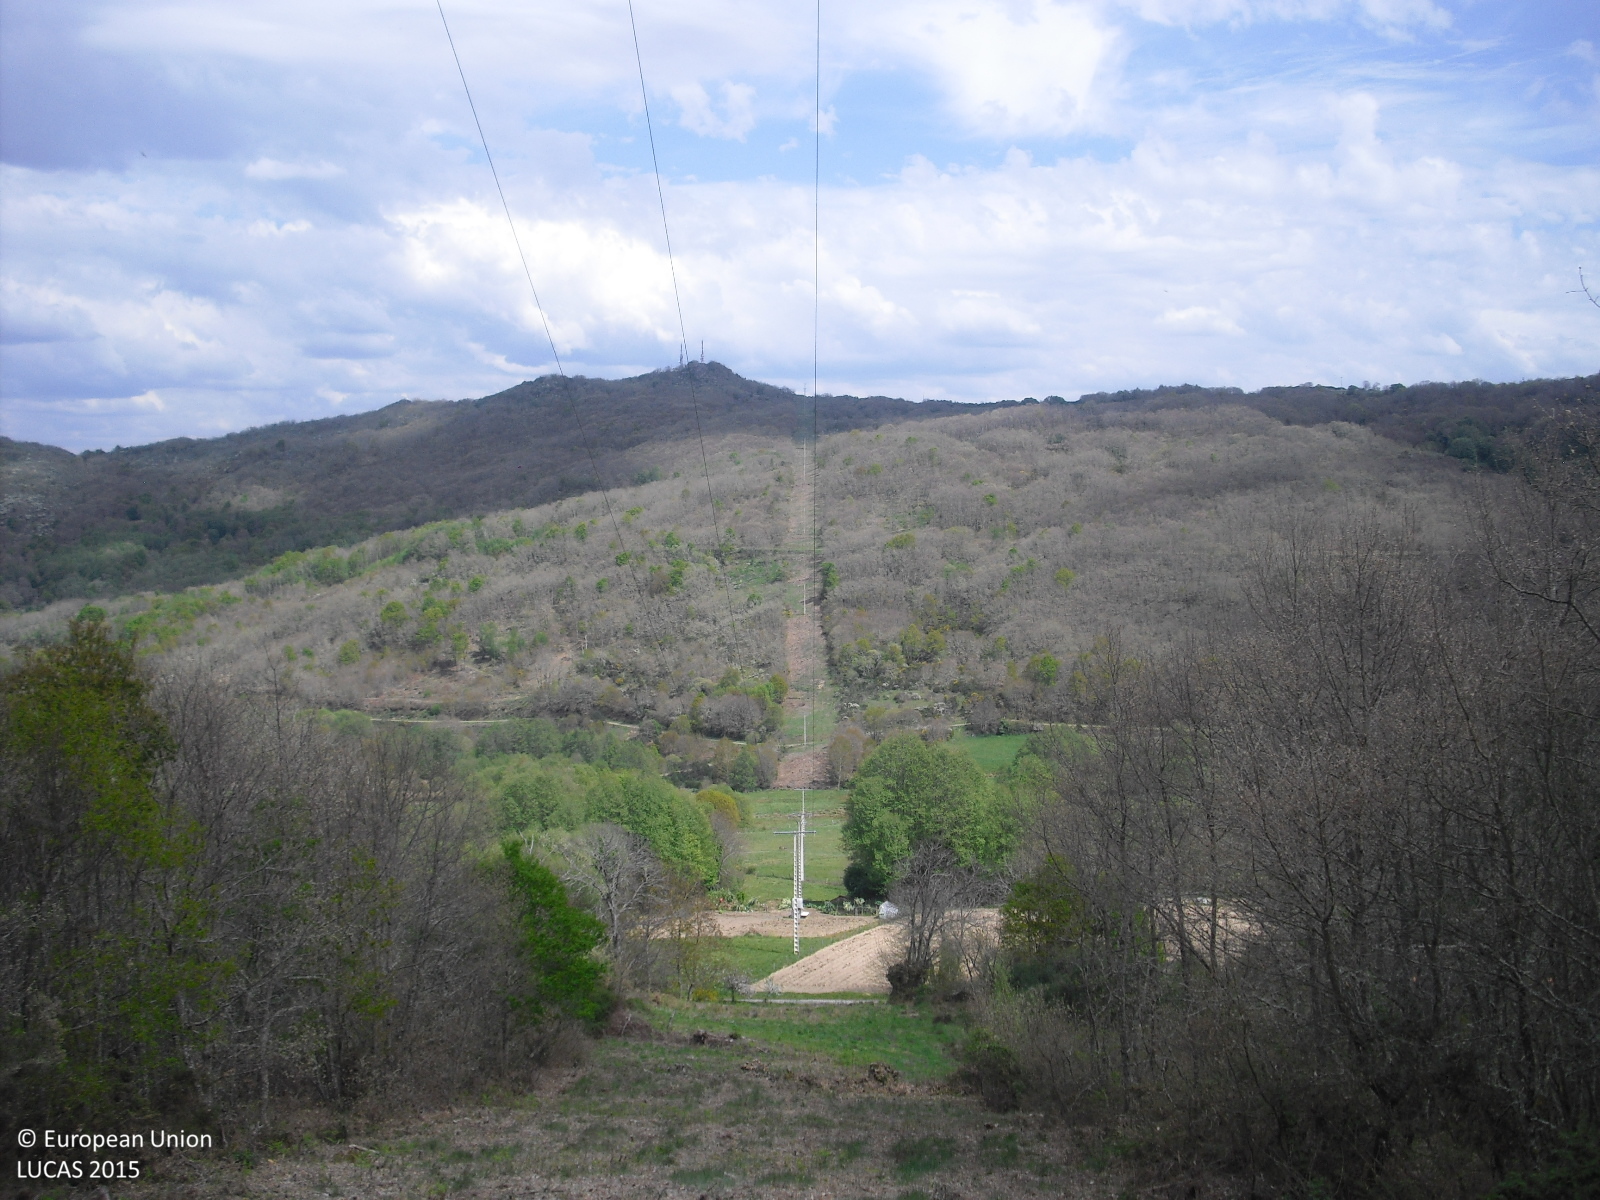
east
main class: Artificial land
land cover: Other artificial areas
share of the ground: < 10 %
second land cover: Shrubland without tree cover
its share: > 75 %
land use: Electricity, gas and thermal power distribution
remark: Fire break
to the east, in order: Artificial constructions in urban areas; Shrubland without tree cover; Tracks; Dry stone walls; Shrubland without tree cover; Grassland without tree/shrub cover; Tracks; Single bushes/trees; Ditches and canals; Grass margins; Paved roads, cycling and walking lanes; Grass margins; Potatoes; Fences; Other fresh vegetables; Fences; Grassland with sparse tree/shrub cover; Broadleaved woodland; Shrubland with sparse tree cover
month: April
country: ES
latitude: 42.0063
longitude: -7.7828
